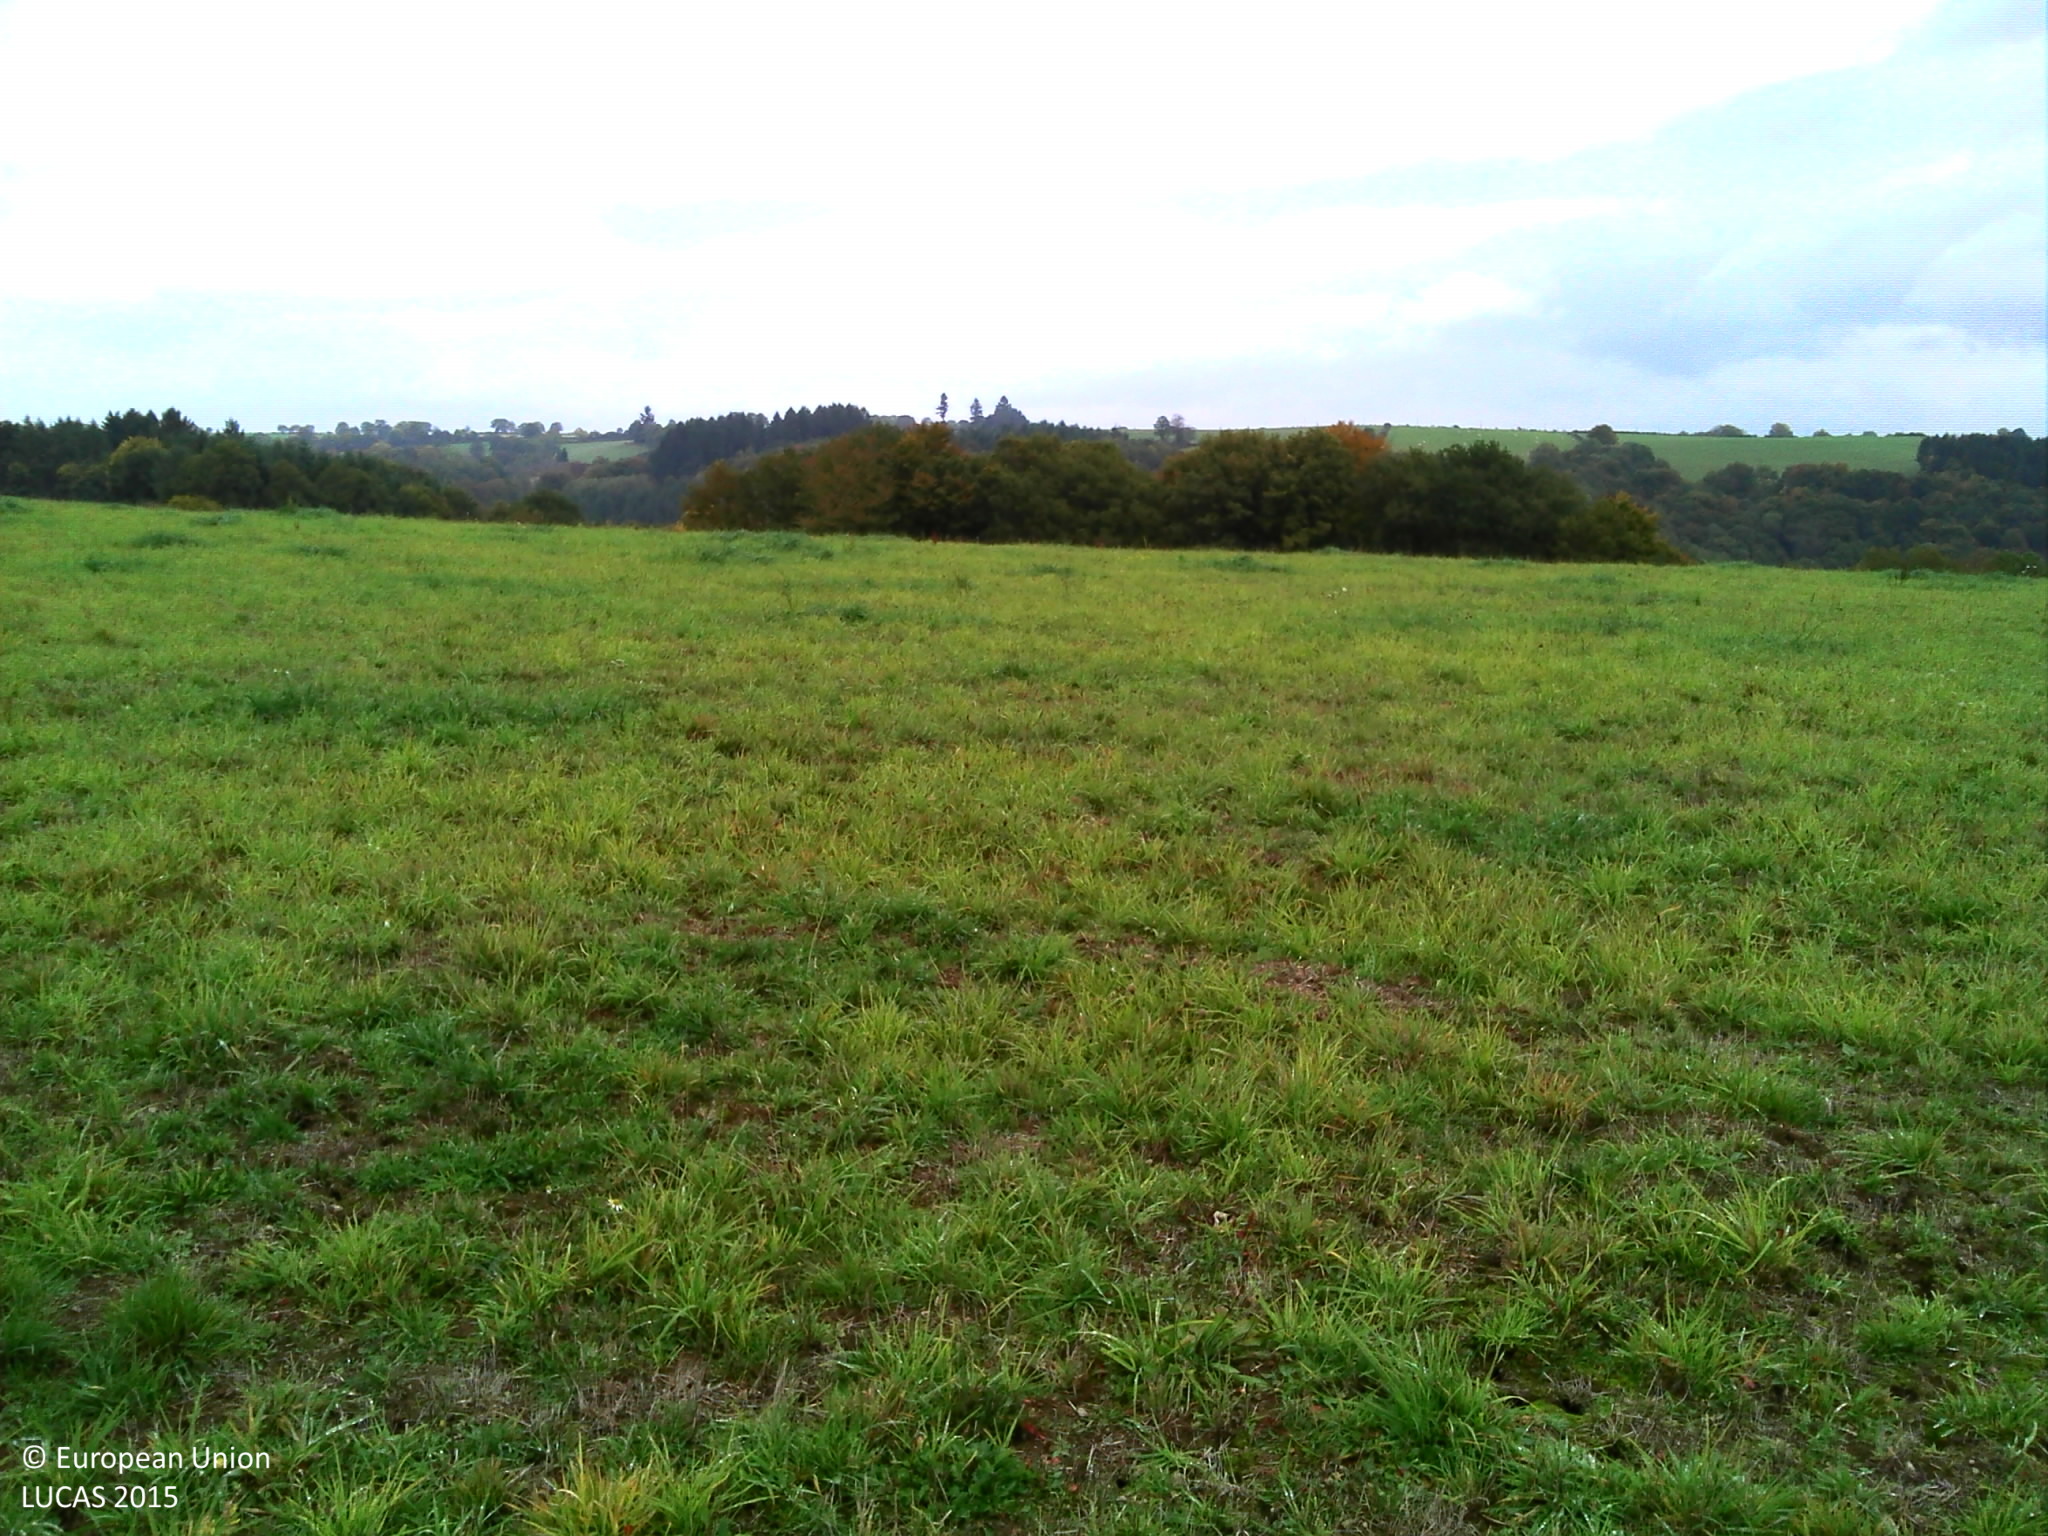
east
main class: Grassland
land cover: Grassland without tree/shrub cover
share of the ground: > 75 %
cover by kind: herbaceous plants 95 %, unconsolidated bare surface 5 %
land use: Agriculture (excluding fallow land and kitchen gardens)
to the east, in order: Grassland without tree/shrub cover; Broadleaved woodland; Fences; Broadleaved woodland
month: October
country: FR
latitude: 46.0020
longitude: 2.8314
